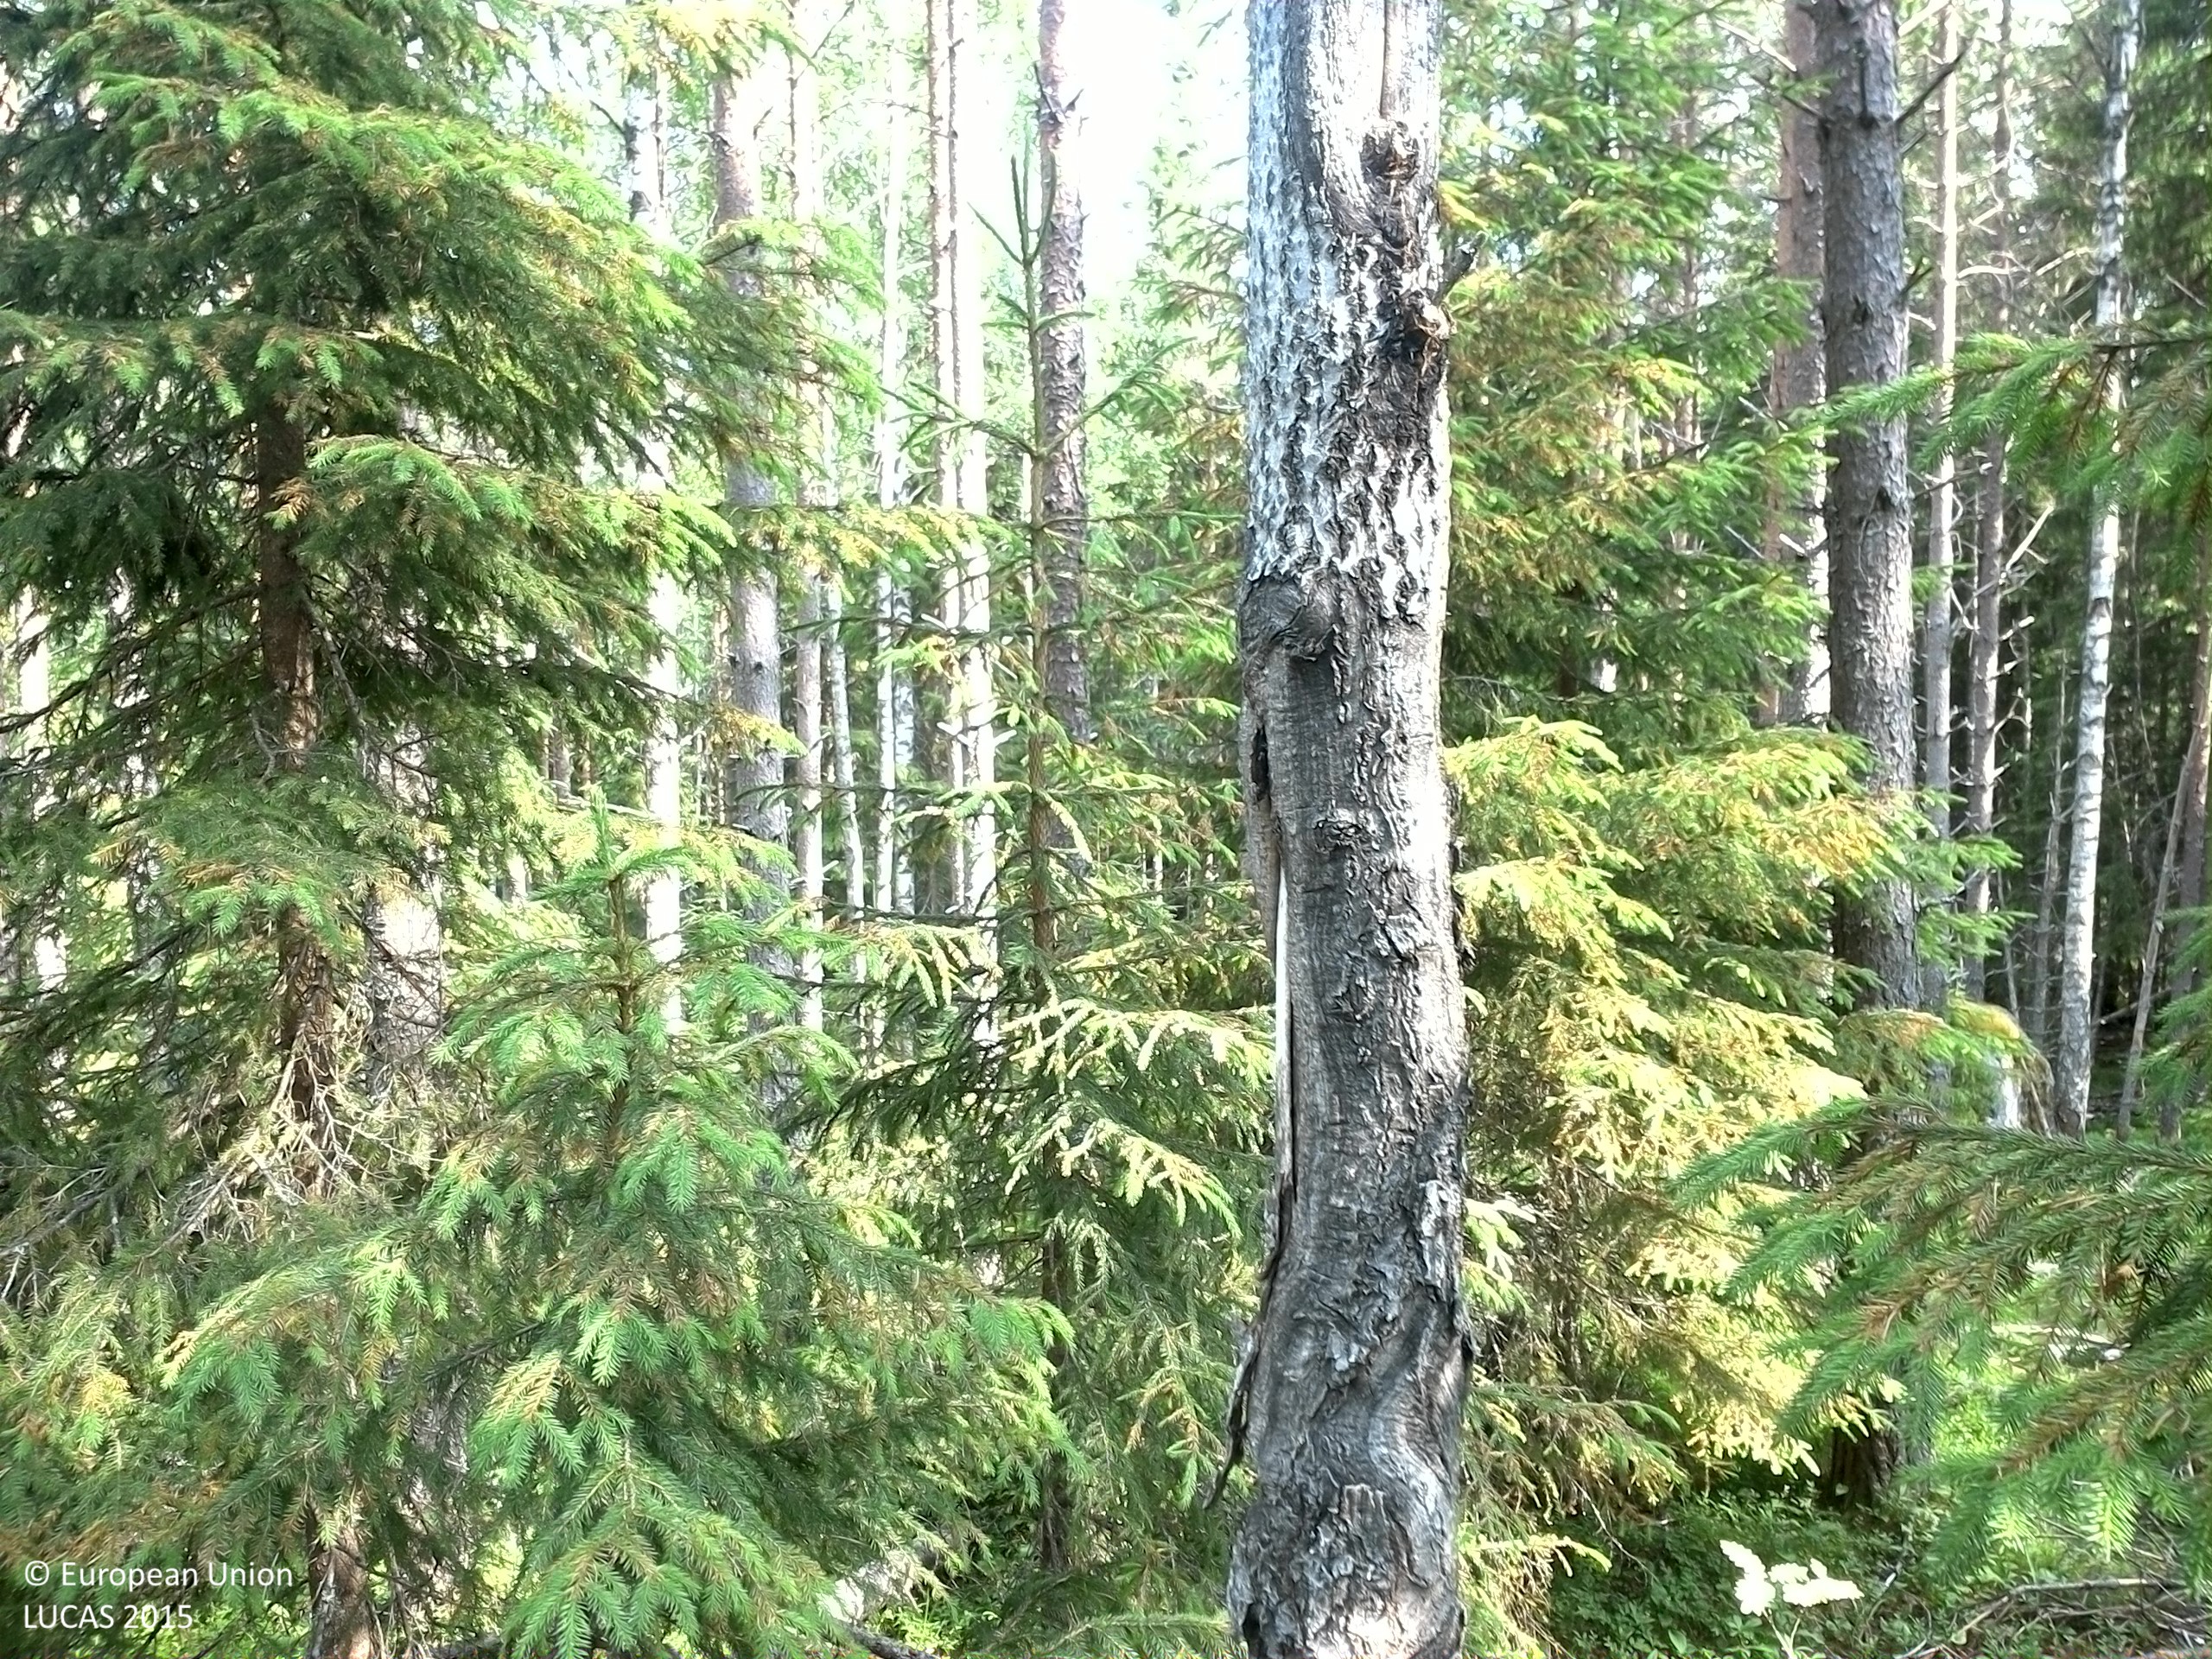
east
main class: Woodland
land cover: Pine dominated coniferous woodland
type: boreal forest
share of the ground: 50 - 75 %
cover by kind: coniferous forest trees 55 %, herbaceous plants 20 %, shrubs 10 %, lichens and mosses 10 %, broadleaved forest trees 5 %
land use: Forestry
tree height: > 5 m
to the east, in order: Pine dominated coniferous woodland; Pine dominated mixed woodland; Spruce dominated mixed woodland; Other mixed woodland; Pine dominated mixed woodland
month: July
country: SE
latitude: 63.5043
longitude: 17.3069
